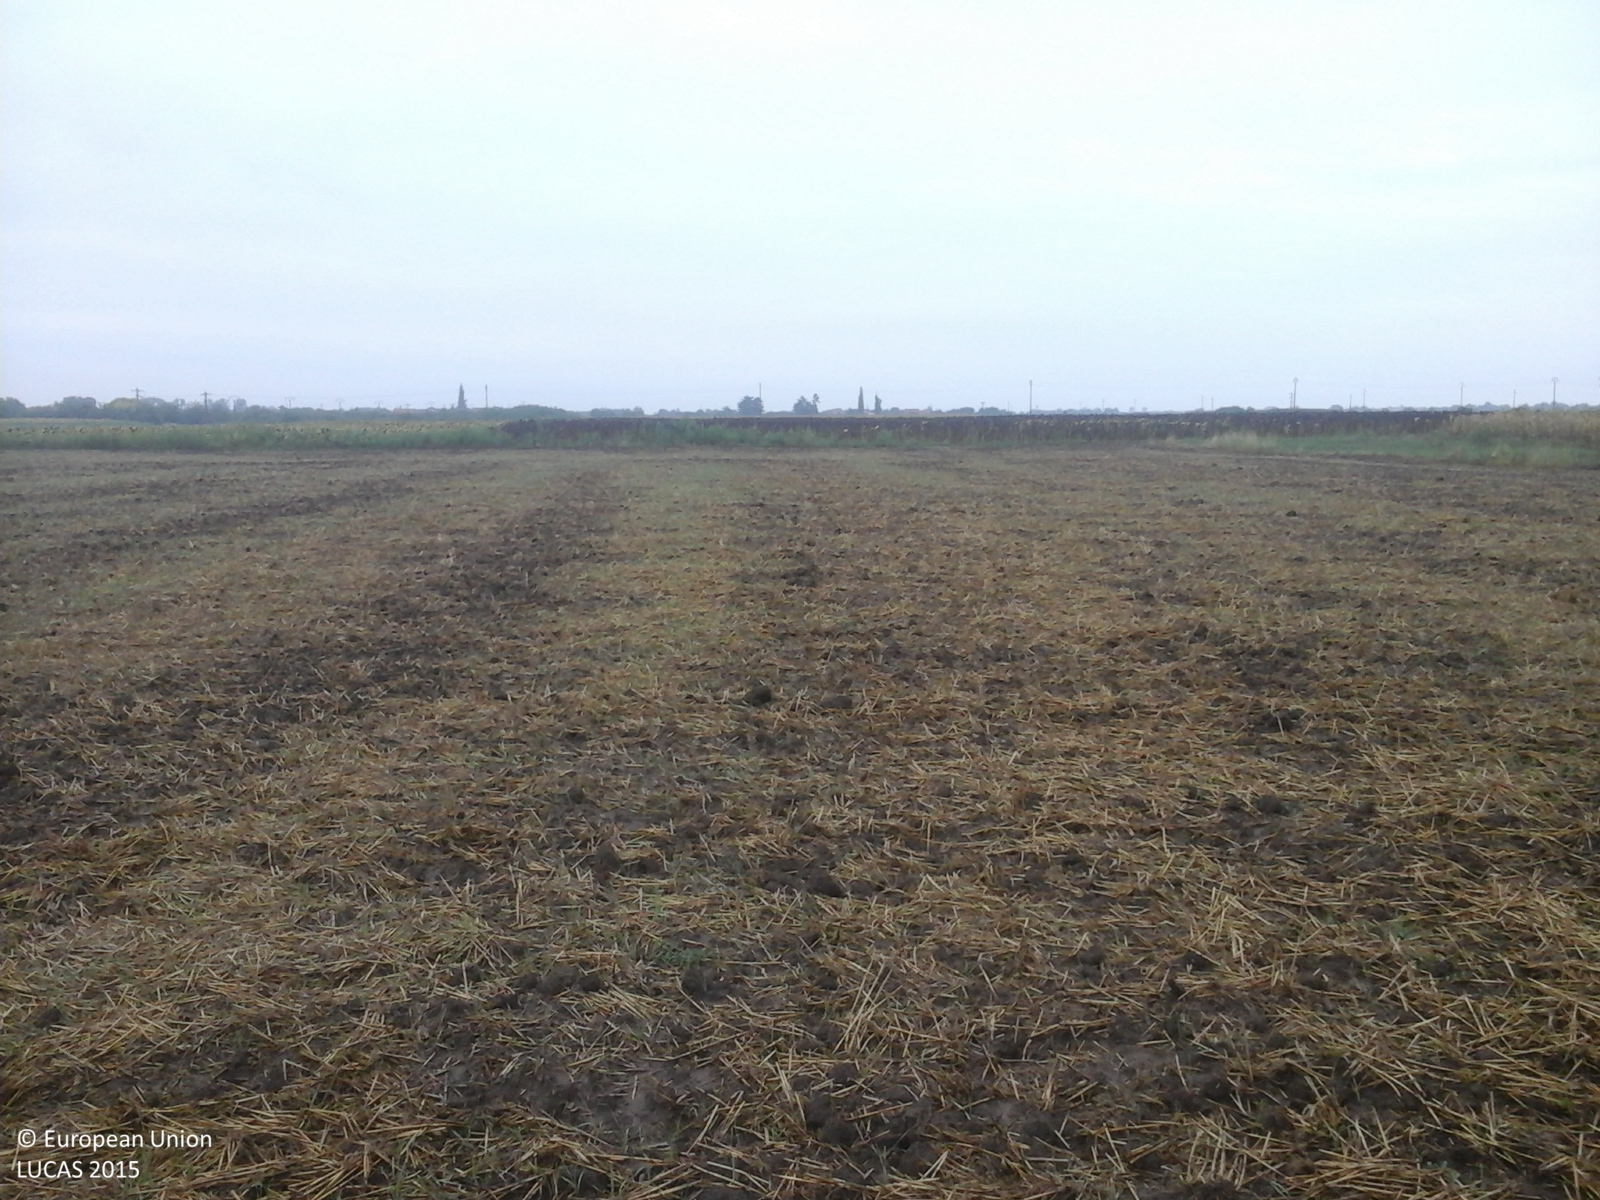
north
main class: Cropland
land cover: Common wheat
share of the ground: < 10 %
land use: Agriculture (excluding fallow land and kitchen gardens)
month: August
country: RO
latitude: 45.6211
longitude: 21.1483
